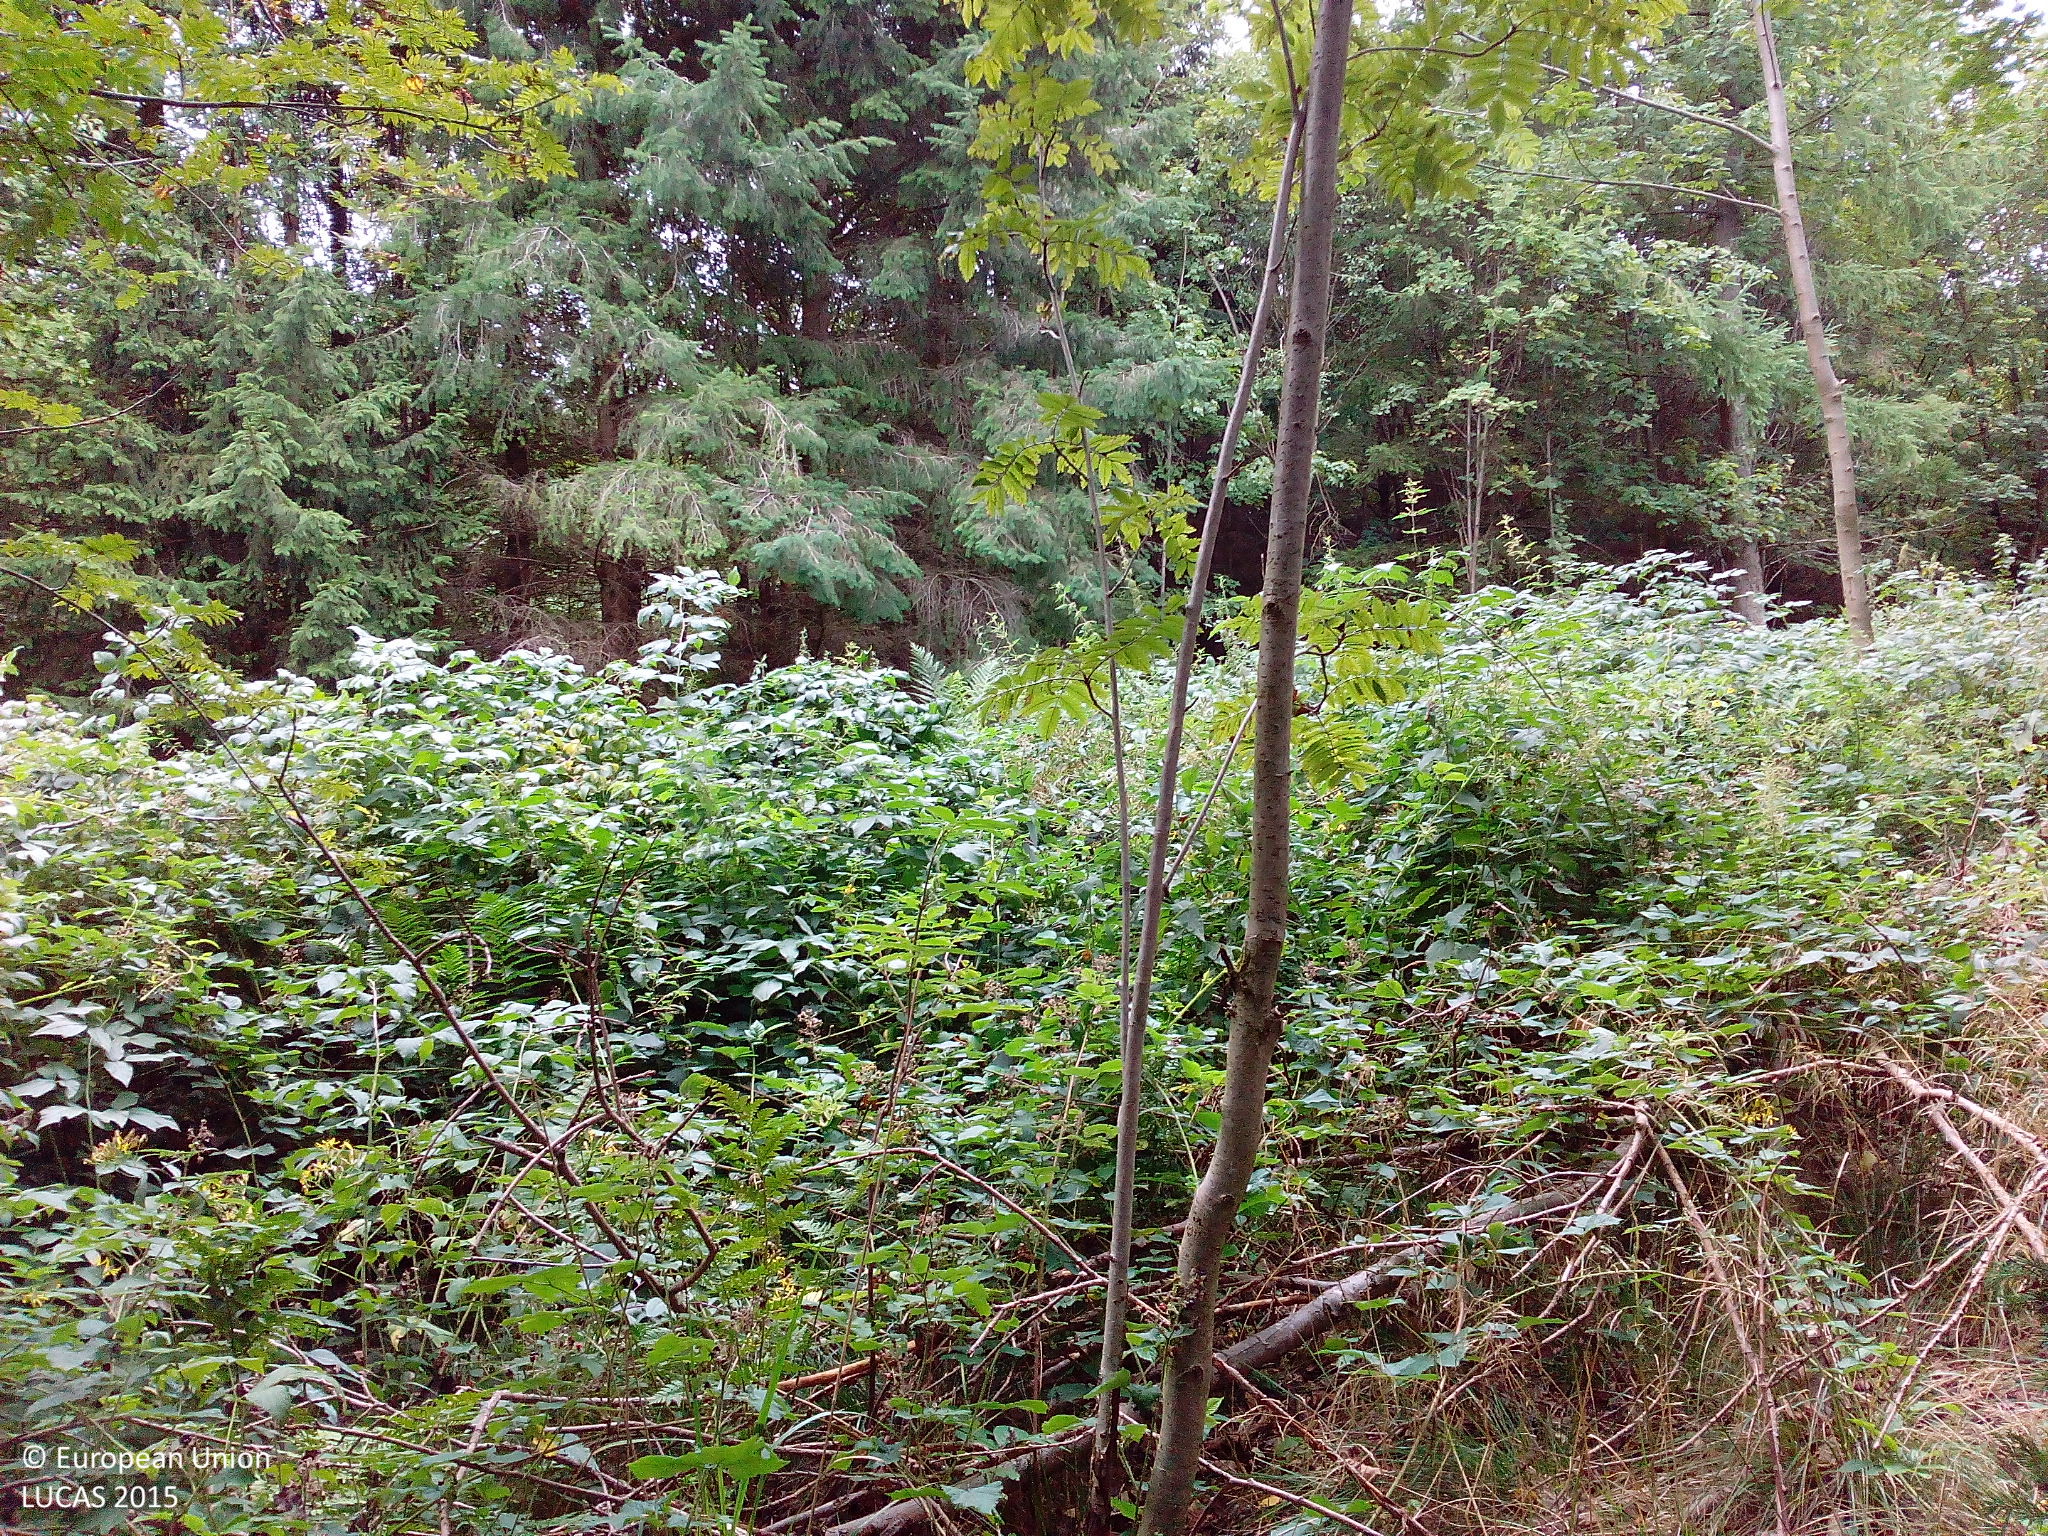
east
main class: Woodland
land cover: Broadleaved woodland
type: thermophilous deciduous forest
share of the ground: > 75 %
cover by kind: broadleaved forest trees 100 %
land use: Forestry
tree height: > 5 m
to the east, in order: Broadleaved woodland; Grass margins; Tracks; Grass margins; Spruce dominated mixed woodland; Ditches and canals; Grass margins; Tracks; Spruce dominated mixed woodland; Fences; Shrubland with sparse tree cover; Fences; Spruce dominated mixed woodland; Fences
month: August
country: DE
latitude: 50.5598
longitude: 9.3085
